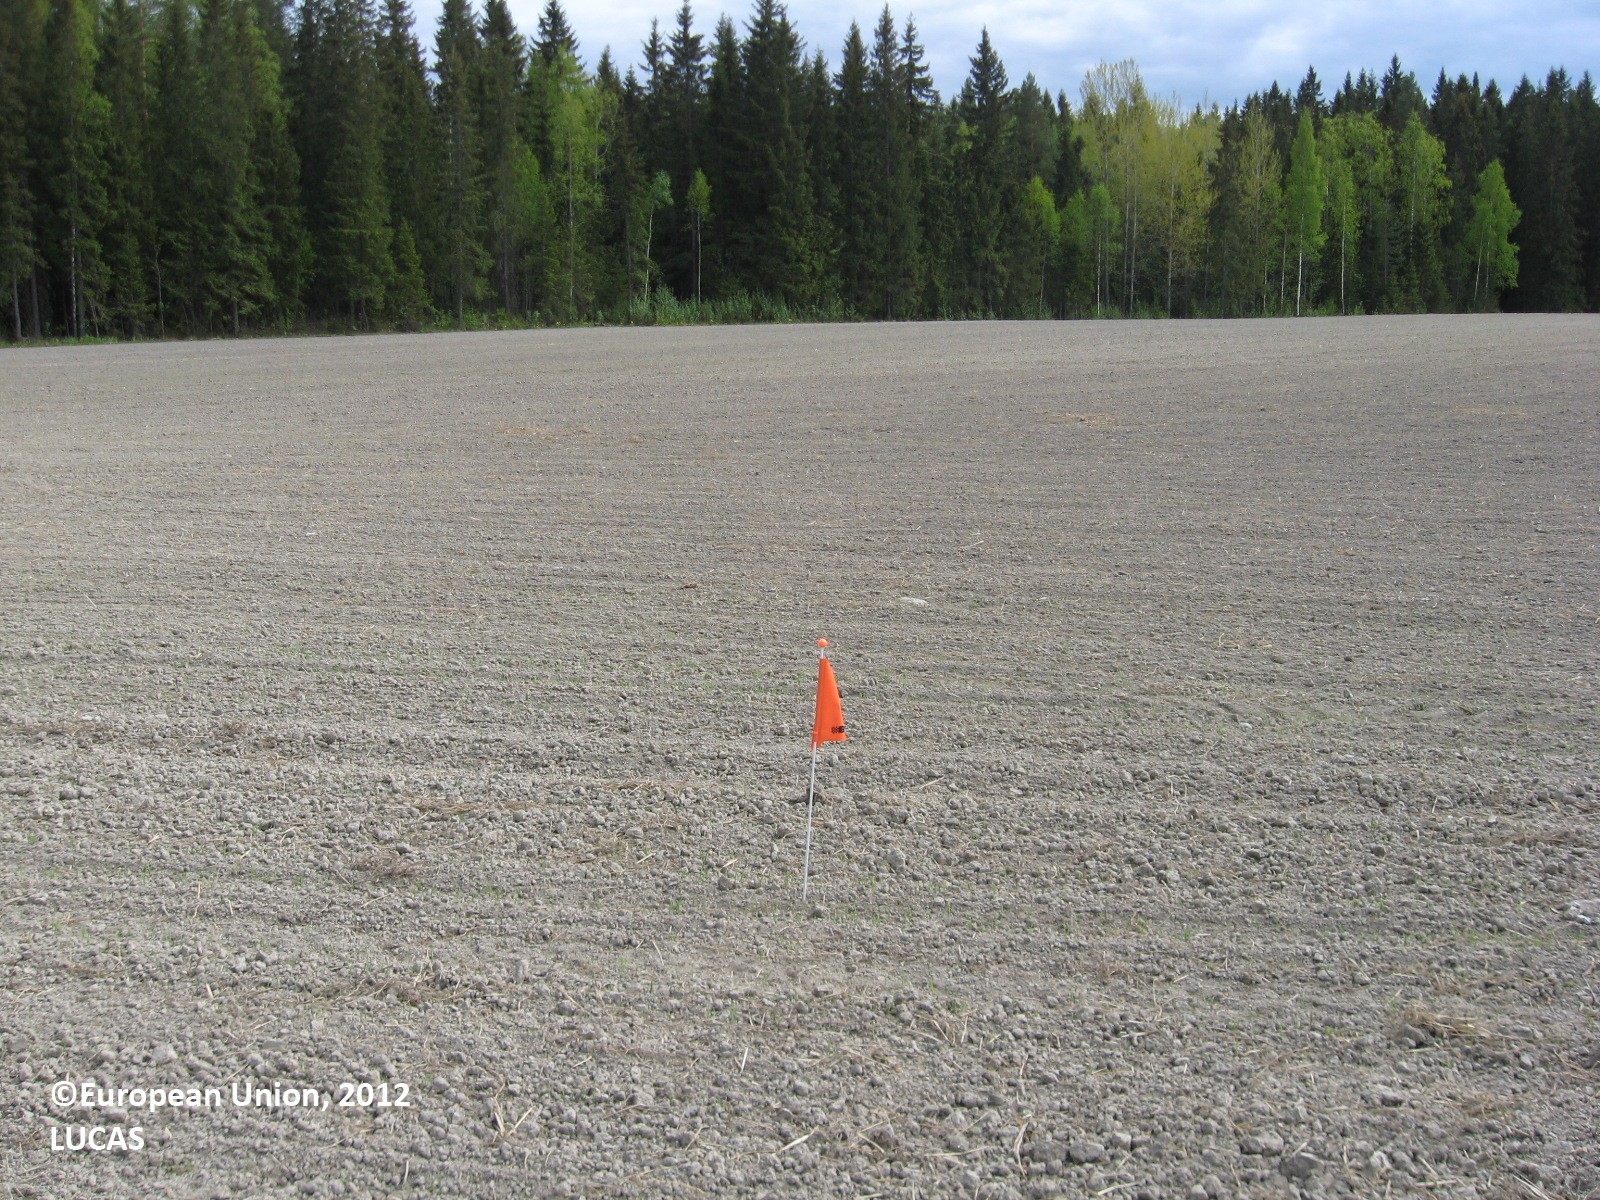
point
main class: Cropland
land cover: Barley
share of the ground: < 10 %
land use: Agriculture (excluding fallow land and kitchen gardens)
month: May
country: FI
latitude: 61.8347
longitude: 22.6928
